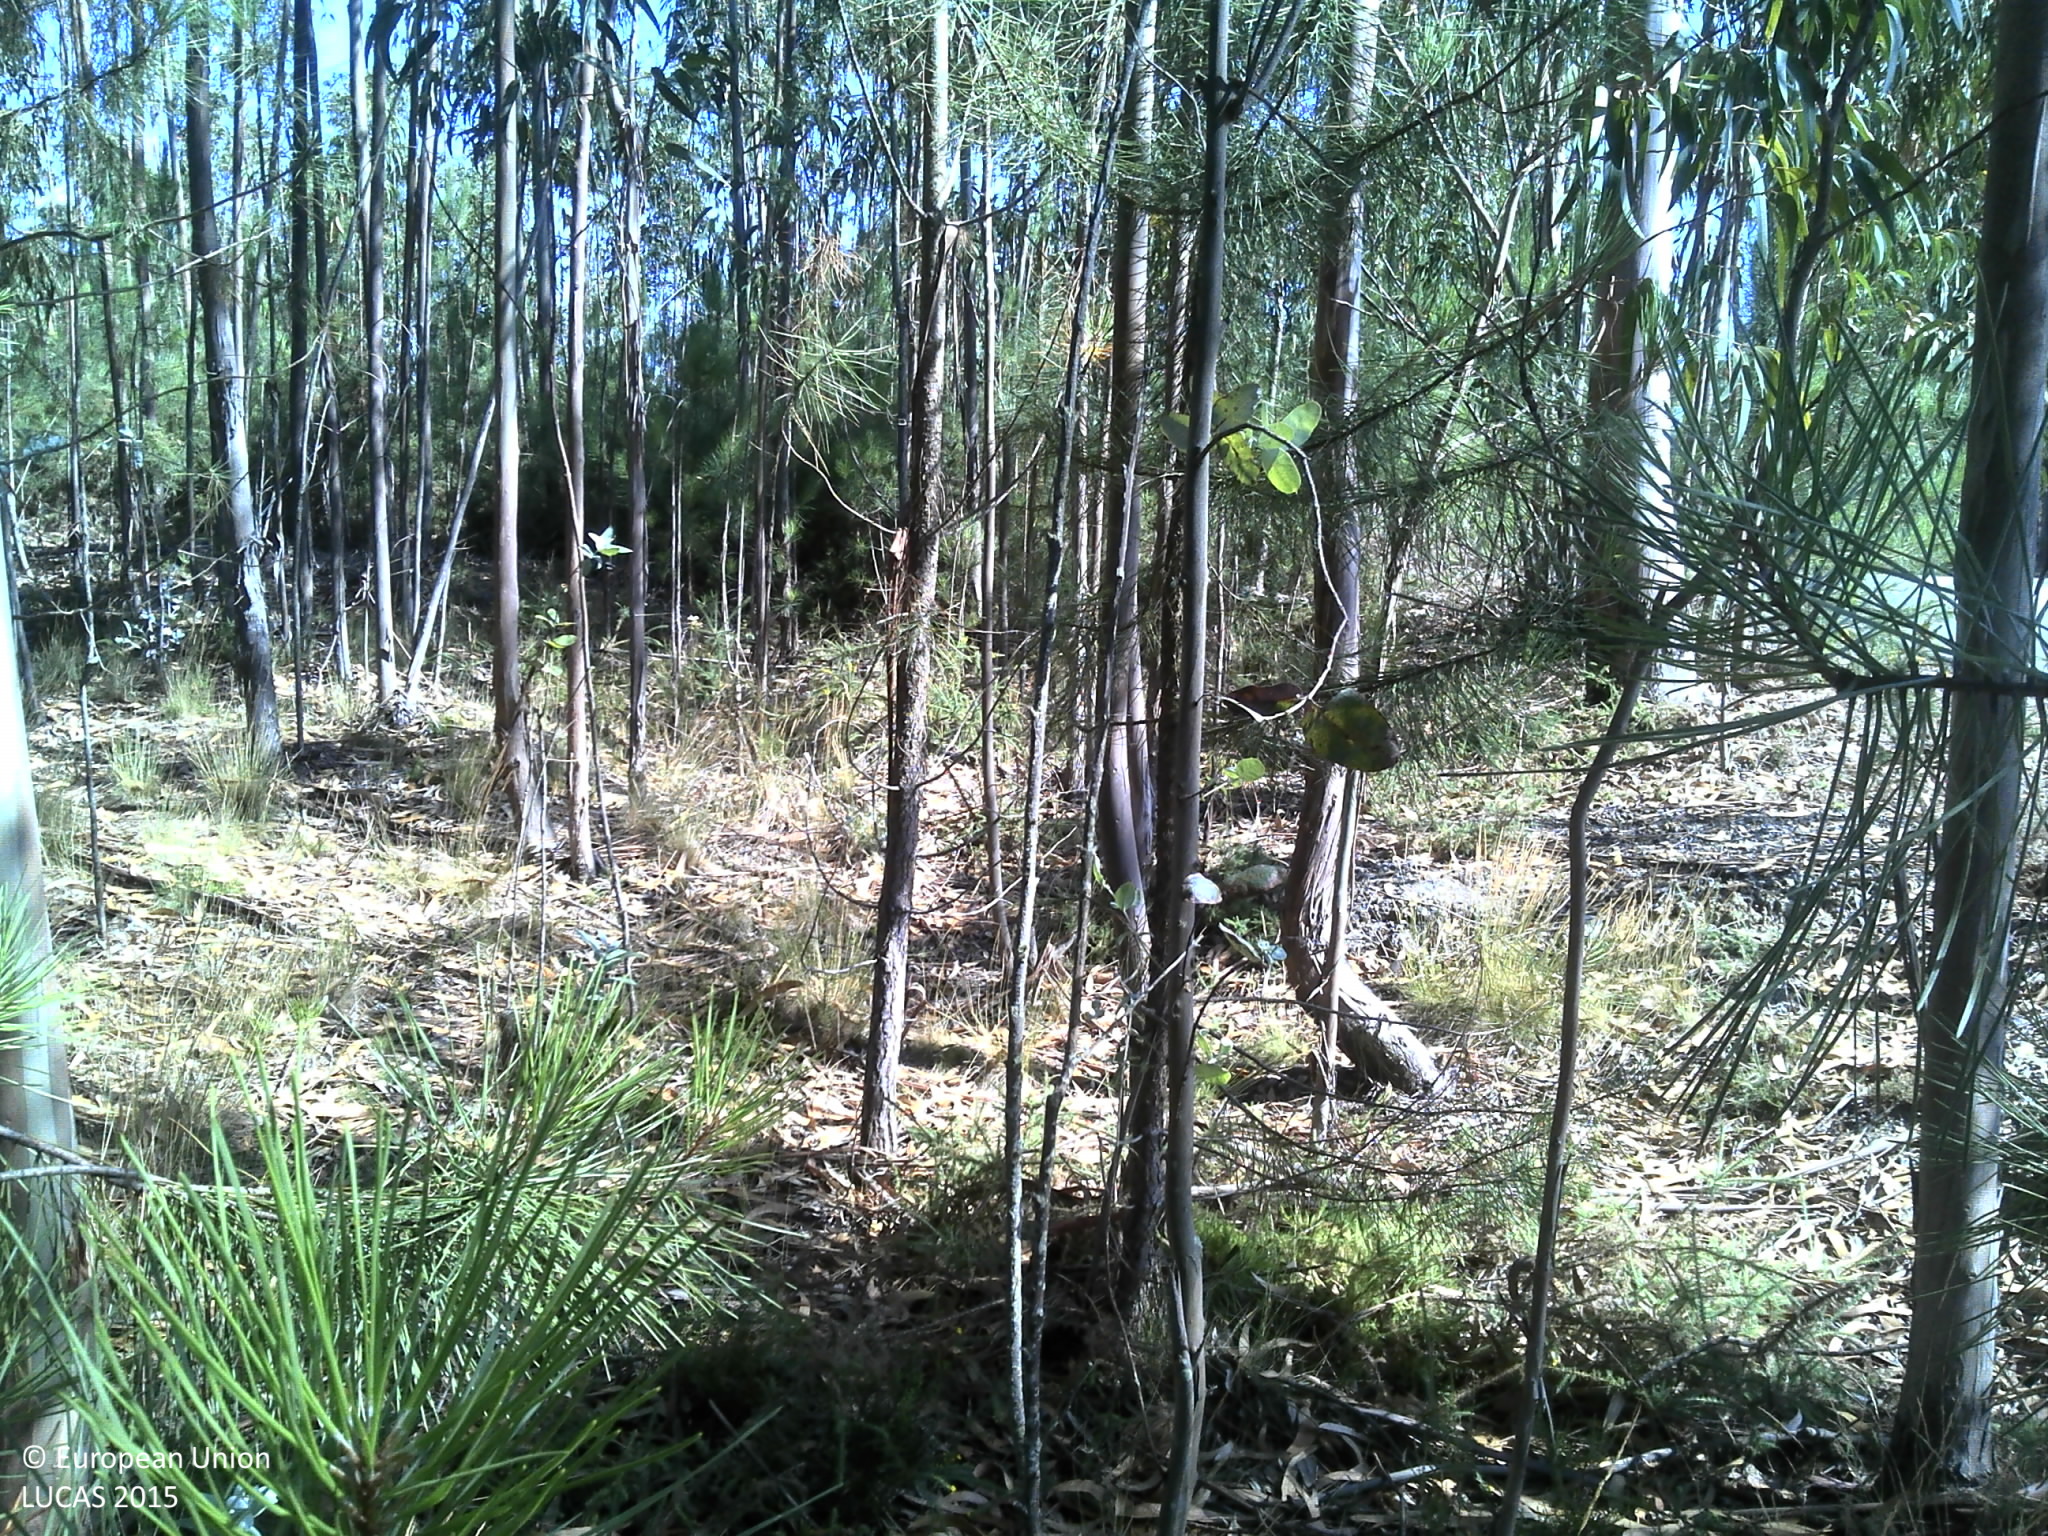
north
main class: Woodland
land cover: Broadleaved woodland
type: exotic forest
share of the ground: 50 - 75 %
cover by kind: broadleaved forest trees 70 %, unconsolidated bare surface 20 %, coniferous forest trees 5 %, shrubs 5 %
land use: Forestry
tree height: > 5 m
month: July
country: PT
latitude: 41.0424
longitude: -8.4053
